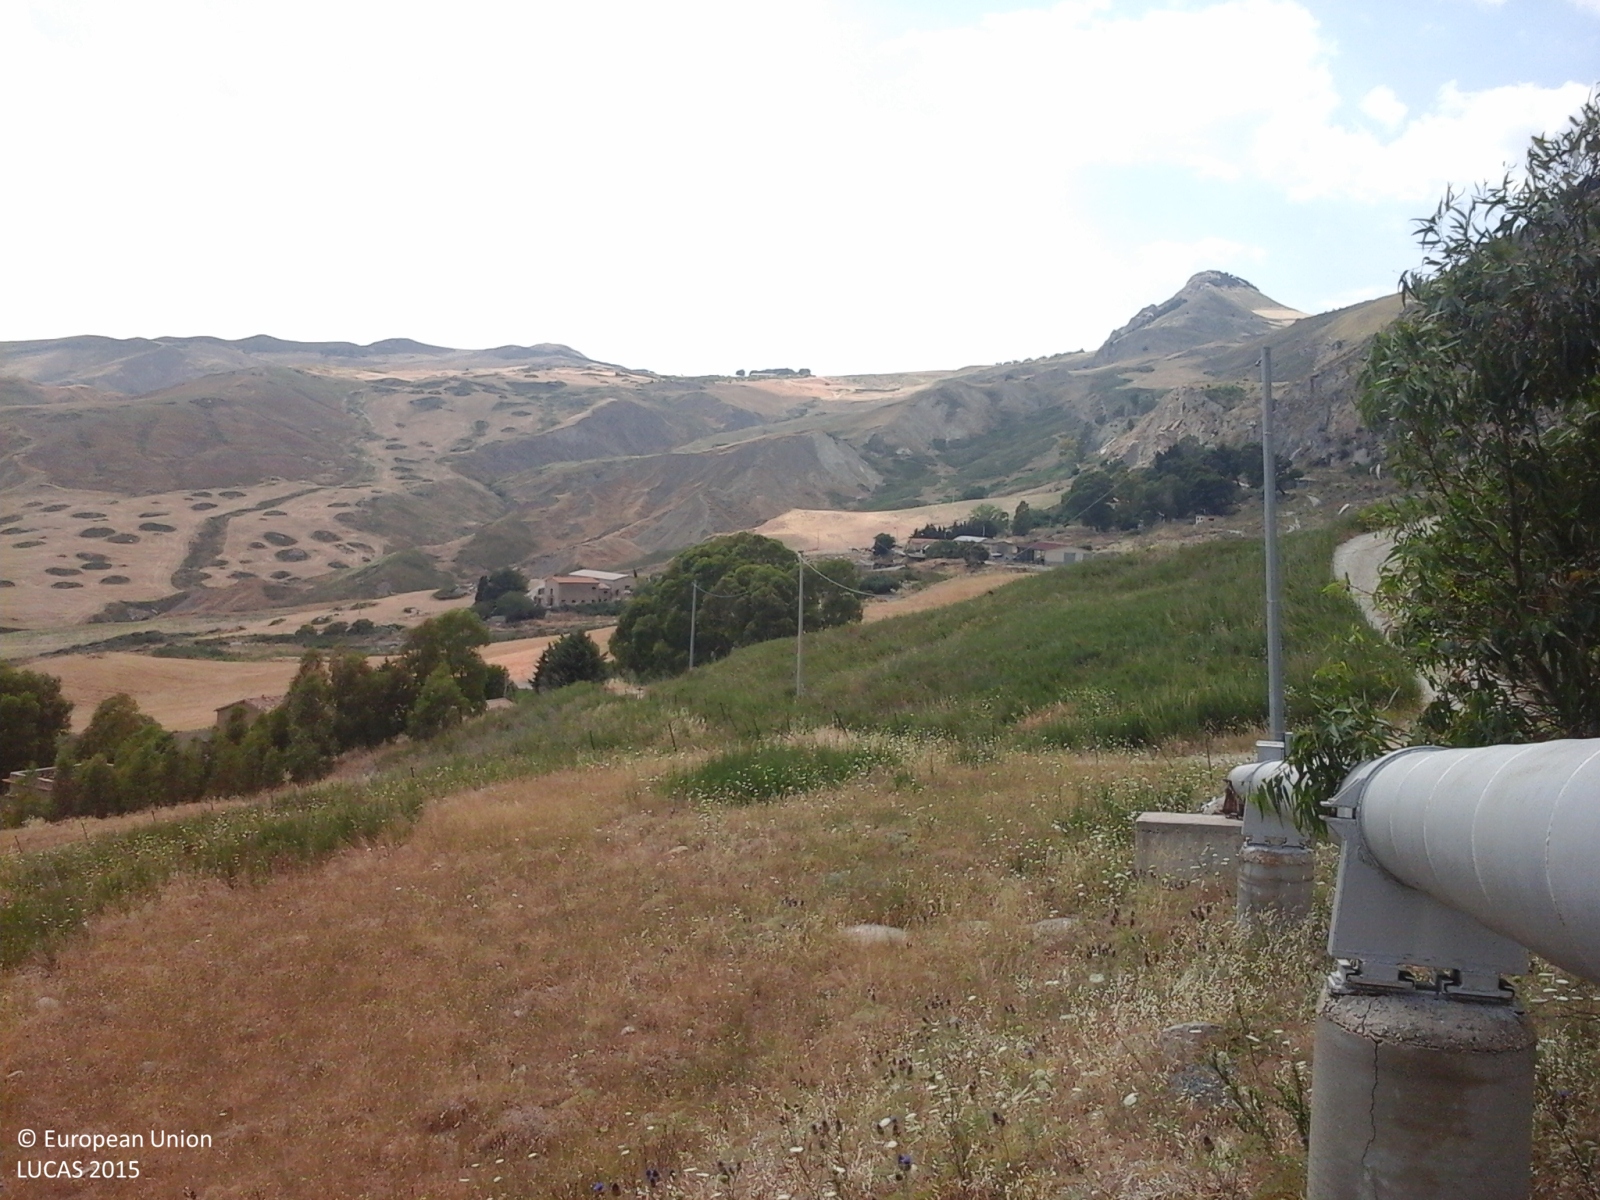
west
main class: Grassland
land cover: Grassland without tree/shrub cover
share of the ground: > 75 %
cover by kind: herbaceous plants 100 %
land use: Abandoned areas
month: July
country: IT
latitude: 37.5916
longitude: 13.5184
